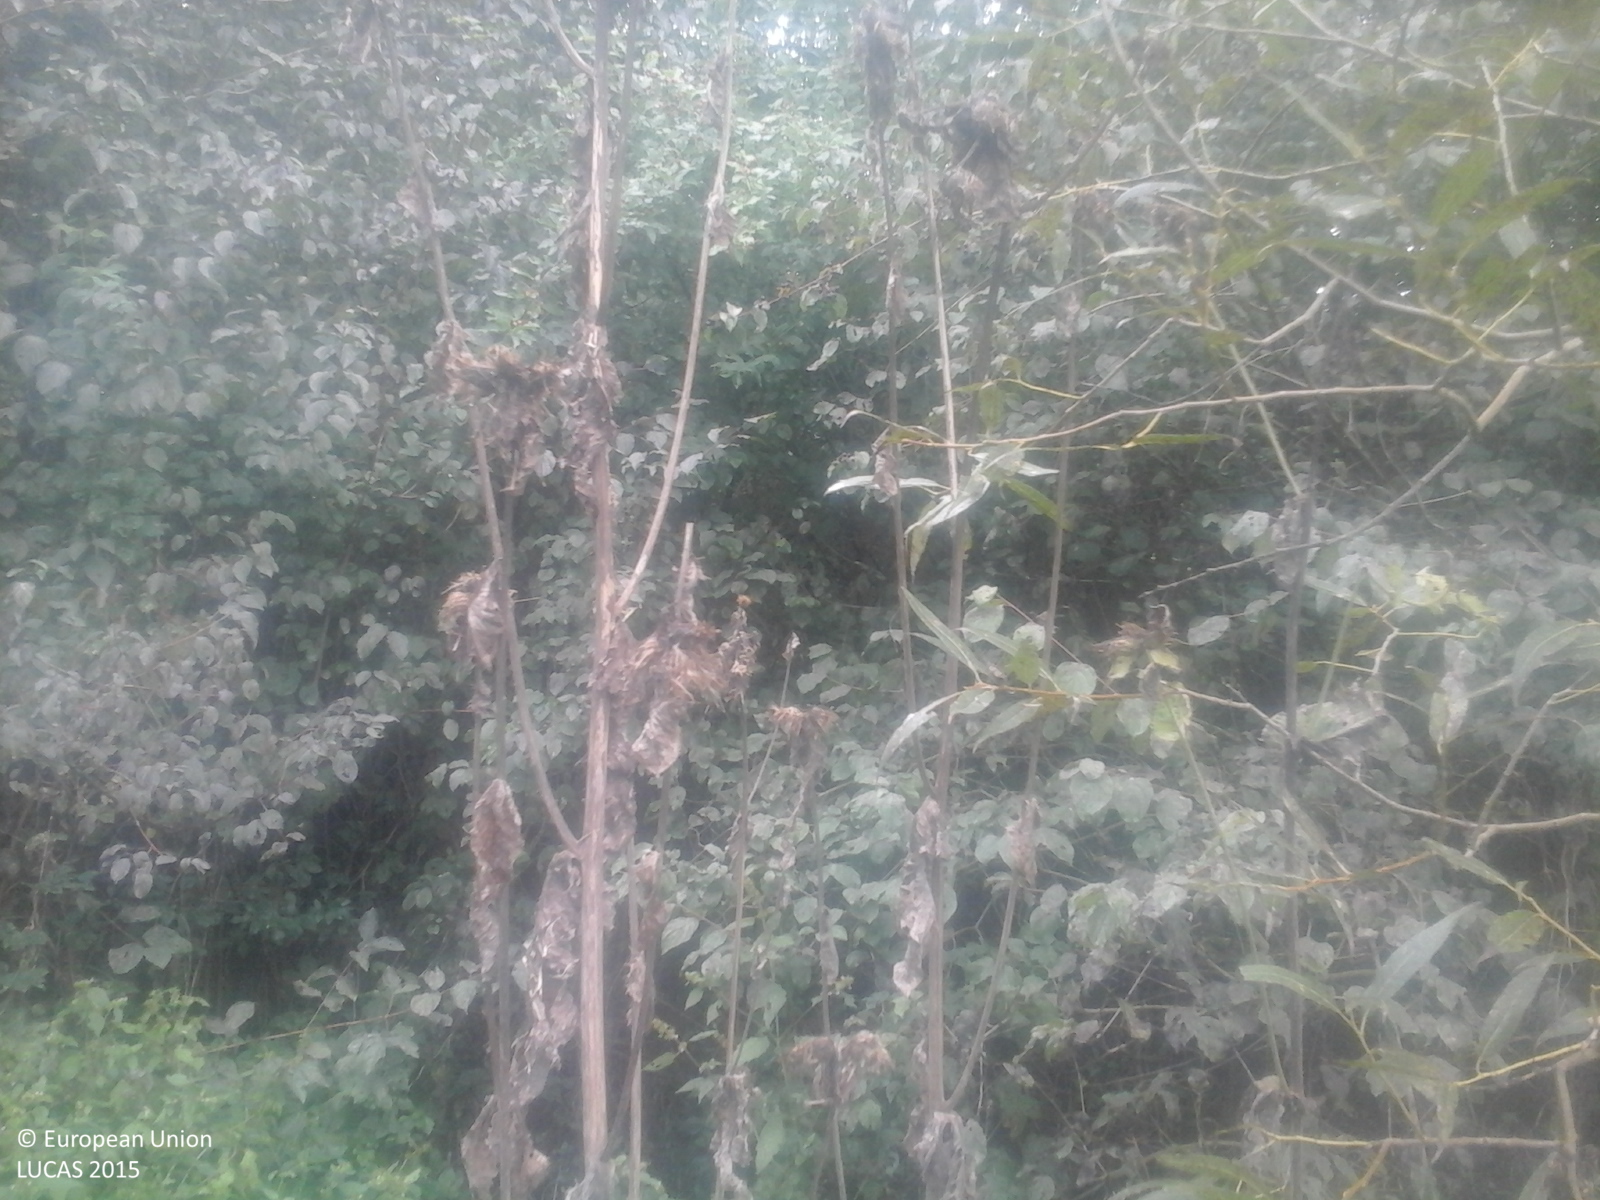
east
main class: Woodland
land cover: Broadleaved woodland
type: mesophytic deciduous forest
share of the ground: > 75 %
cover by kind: broadleaved forest trees 100 %
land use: Forestry
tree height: > 5 m
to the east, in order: Broadleaved woodland; Tracks; Broadleaved woodland; Grassland without tree/shrub cover; Broadleaved woodland; Grassland without tree/shrub cover
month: September
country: RO
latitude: 46.8388
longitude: 22.3101
